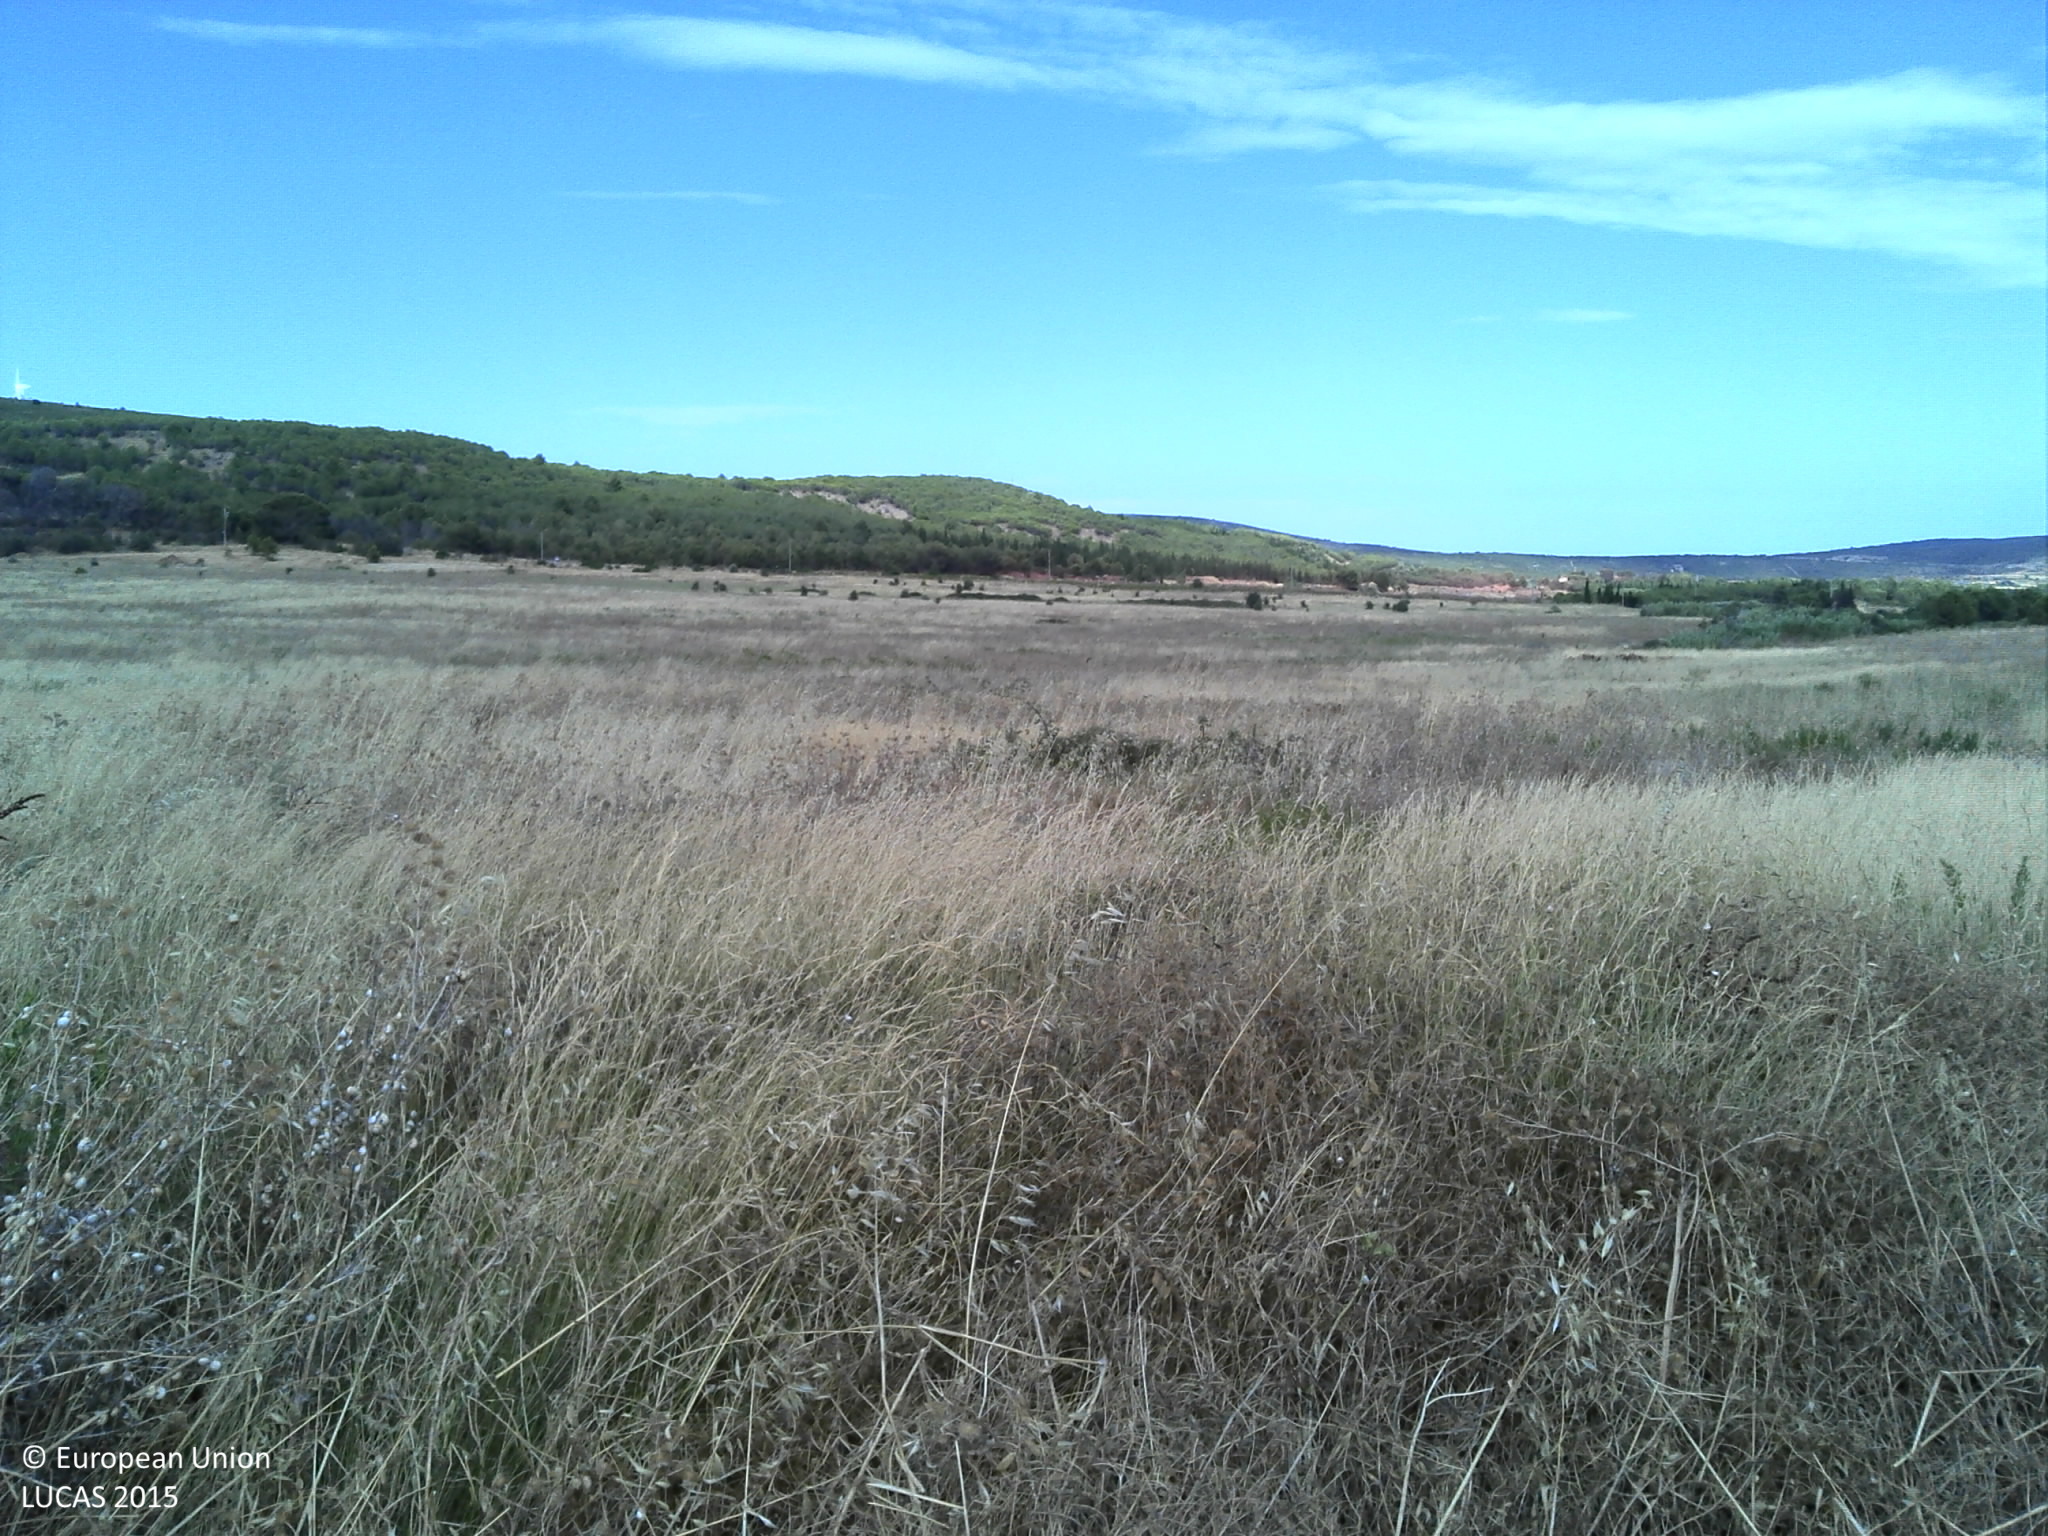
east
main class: Grassland
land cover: Spontaneously vegetated surfaces
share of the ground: > 75 %
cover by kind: herbaceous plants 100 %
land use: Fallow land
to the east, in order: Spontaneously vegetated surfaces
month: July
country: FR
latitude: 43.5190
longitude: 3.5885
